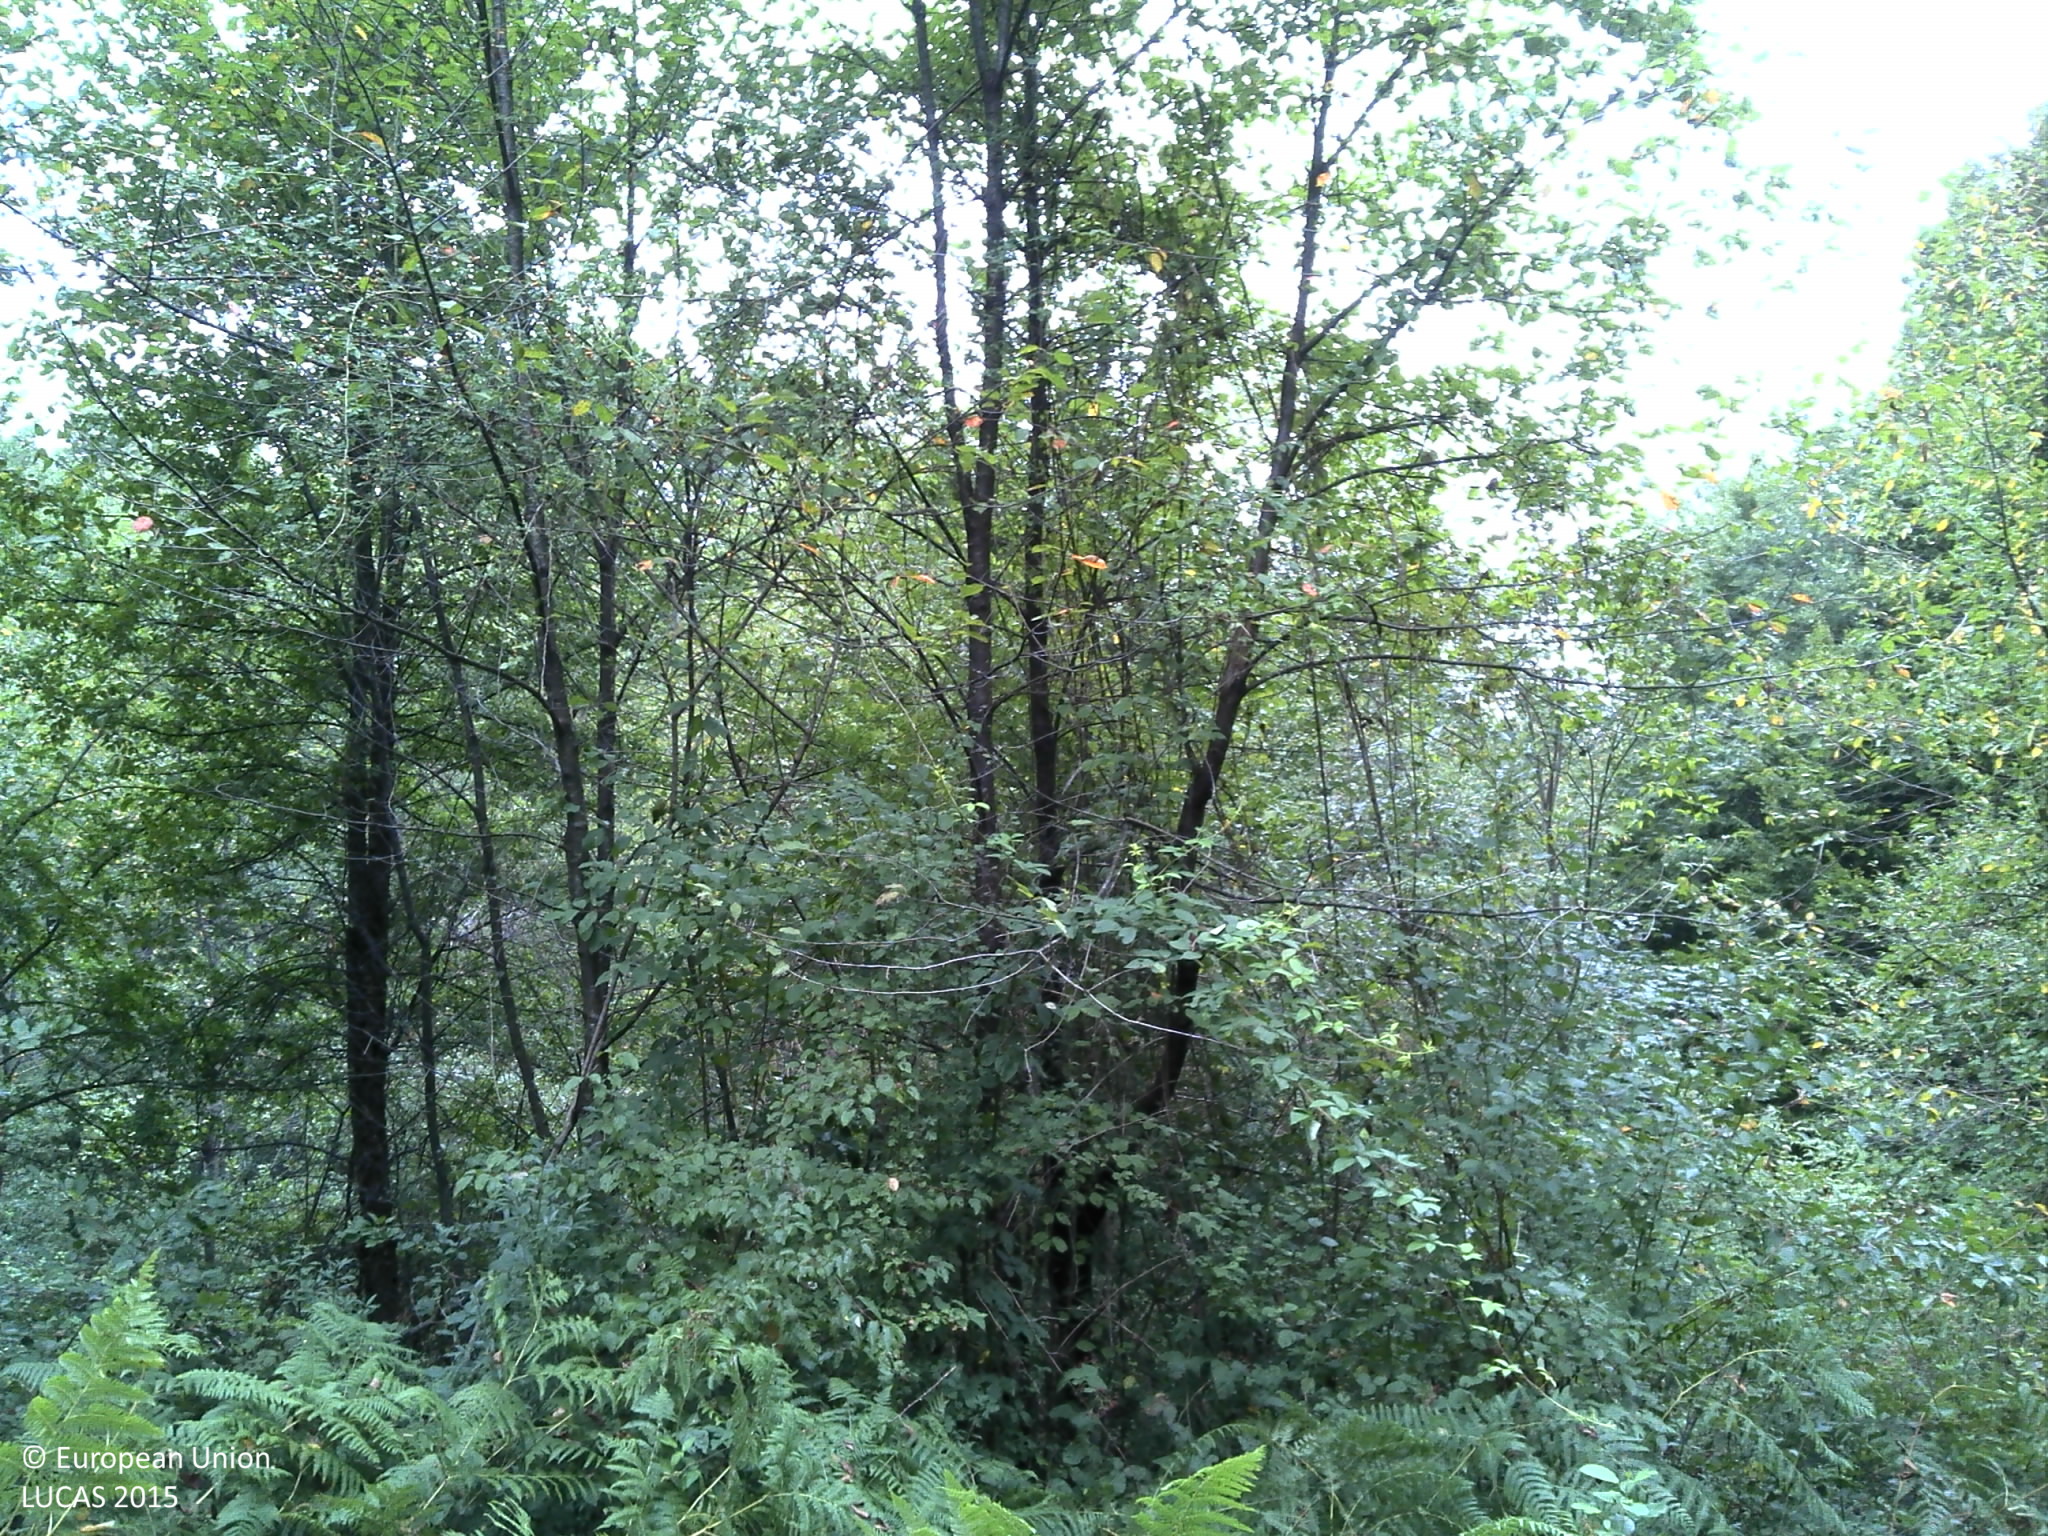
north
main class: Woodland
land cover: Broadleaved woodland
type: mesophytic deciduous forest
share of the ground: 50 - 75 %
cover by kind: broadleaved forest trees 75 %, shrubs 20 %, herbaceous plants 5 %
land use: Semi-natural and natural areas not in use
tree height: > 5 m
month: August
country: HR
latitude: 45.3337
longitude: 15.6743
